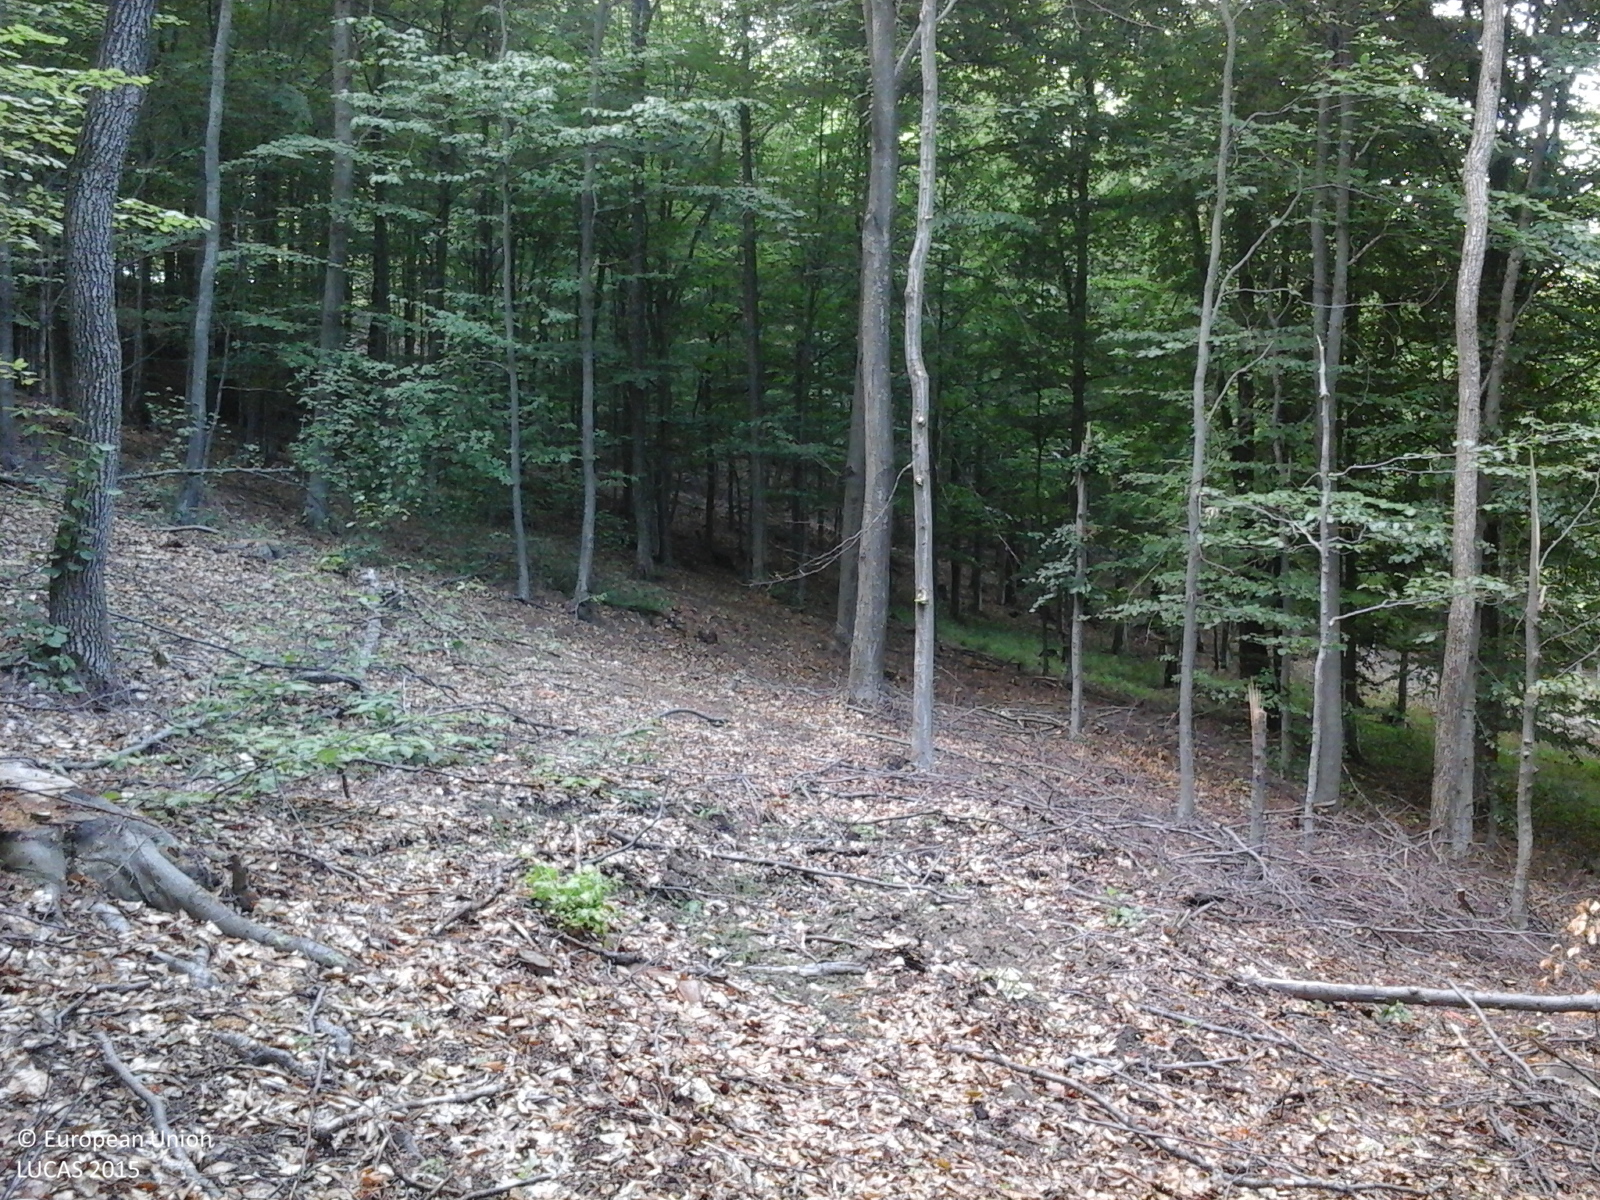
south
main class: Woodland
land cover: Broadleaved woodland
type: beech forest
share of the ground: > 75 %
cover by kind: broadleaved forest trees 100 %
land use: Forestry
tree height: > 5 m
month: June
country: RO
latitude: 47.0759
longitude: 26.4007
